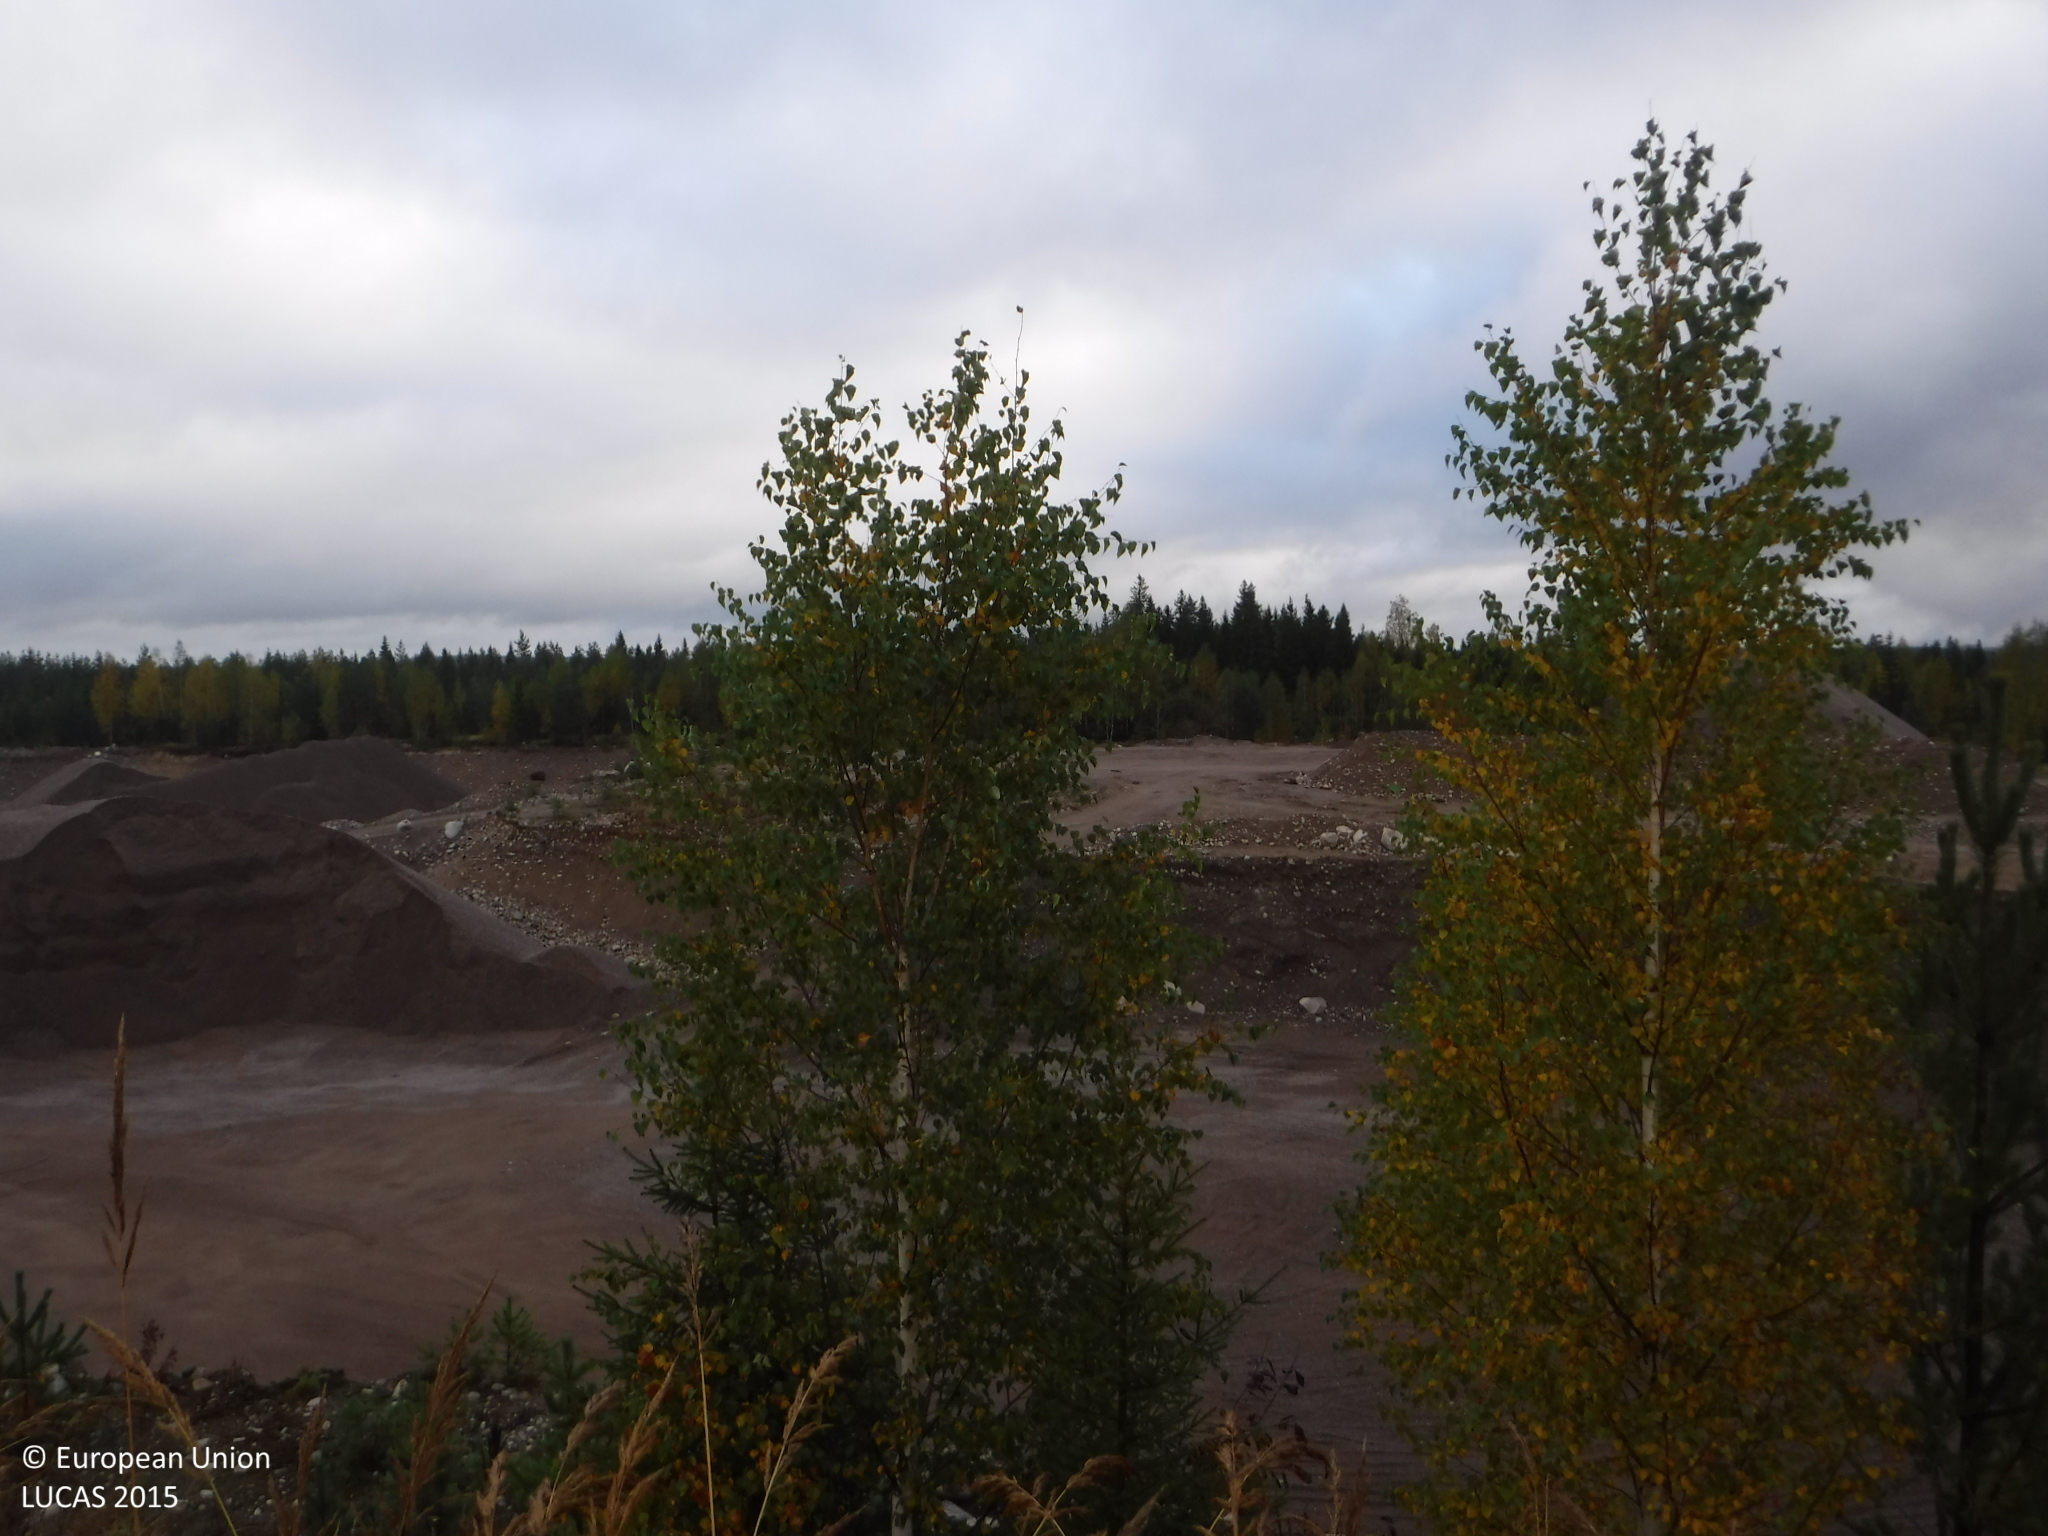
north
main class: Grassland
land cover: Grassland without tree/shrub cover
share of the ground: > 75 %
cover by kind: herbaceous plants 100 %
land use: Mining and quarrying
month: September
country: FI
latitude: 61.8636
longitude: 24.1745
